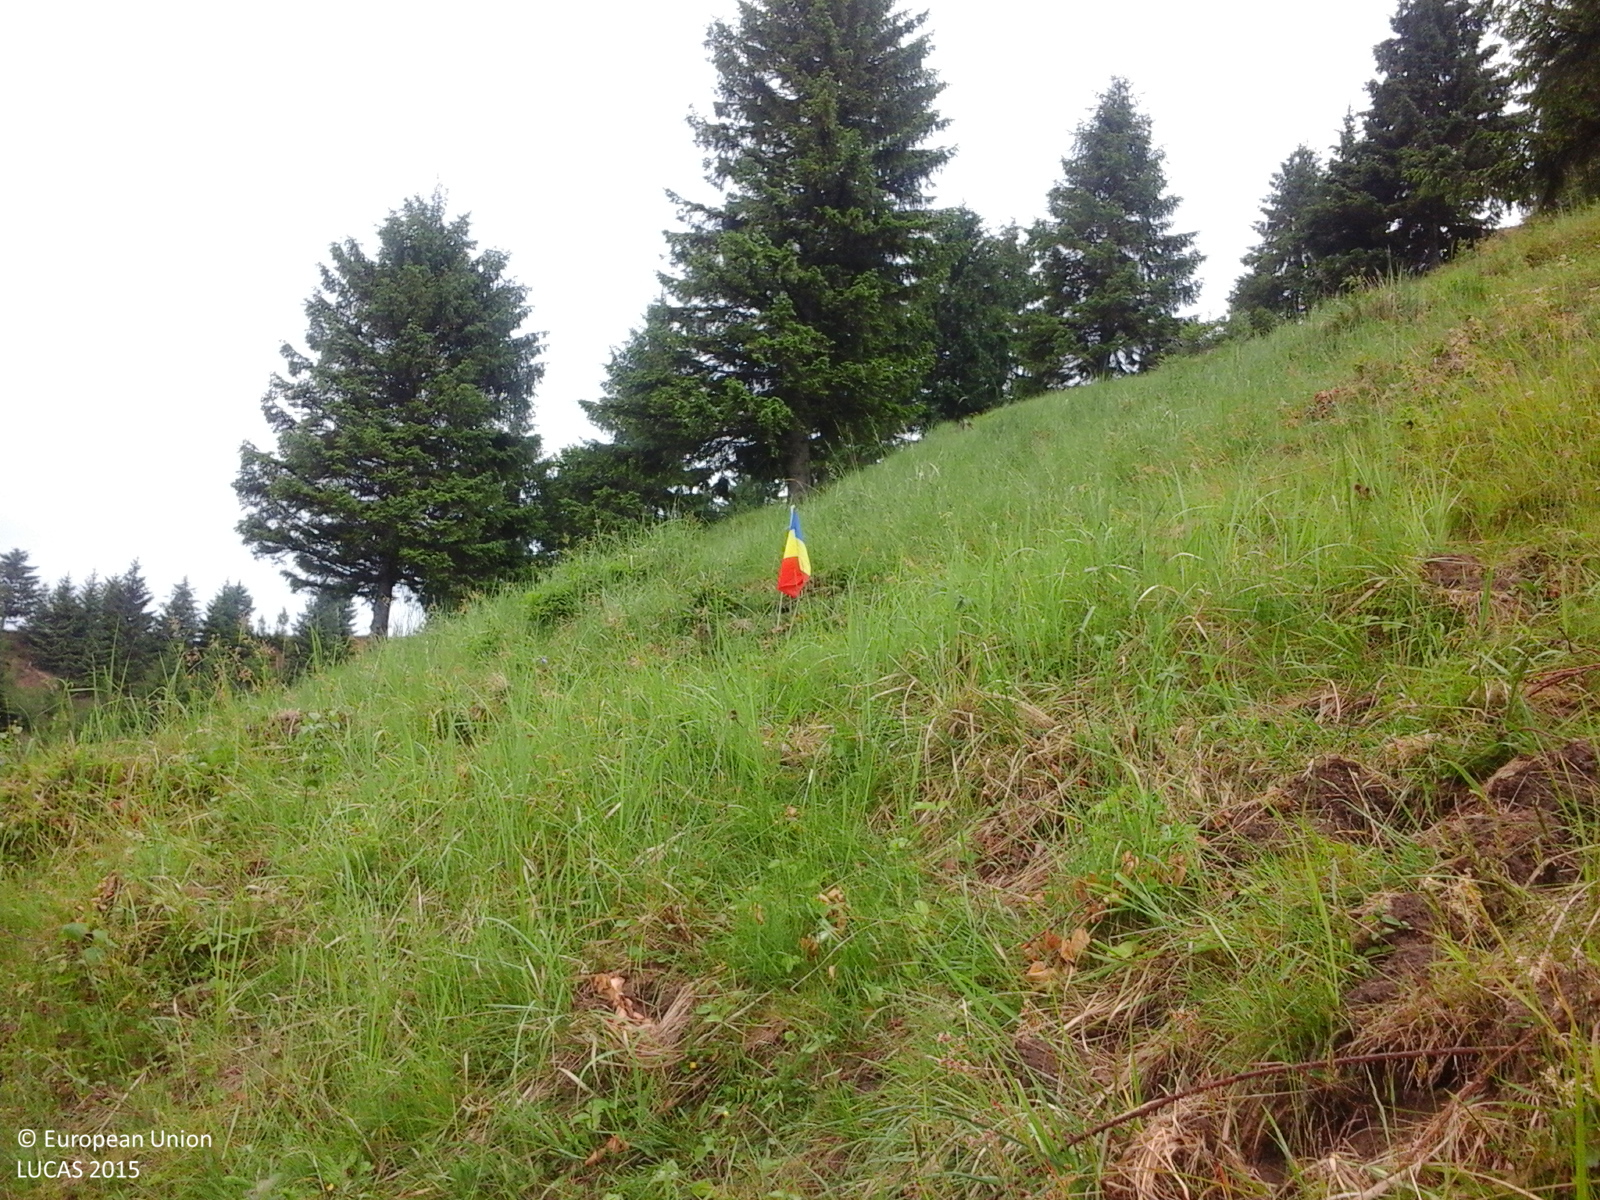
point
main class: Grassland
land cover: Grassland with sparse tree/shrub cover
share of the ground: > 75 %
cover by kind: herbaceous plants 95 %, coniferous forest trees 5 %
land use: Agriculture (excluding fallow land and kitchen gardens)
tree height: > 5 m
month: June
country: RO
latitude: 46.4179
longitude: 26.3806
